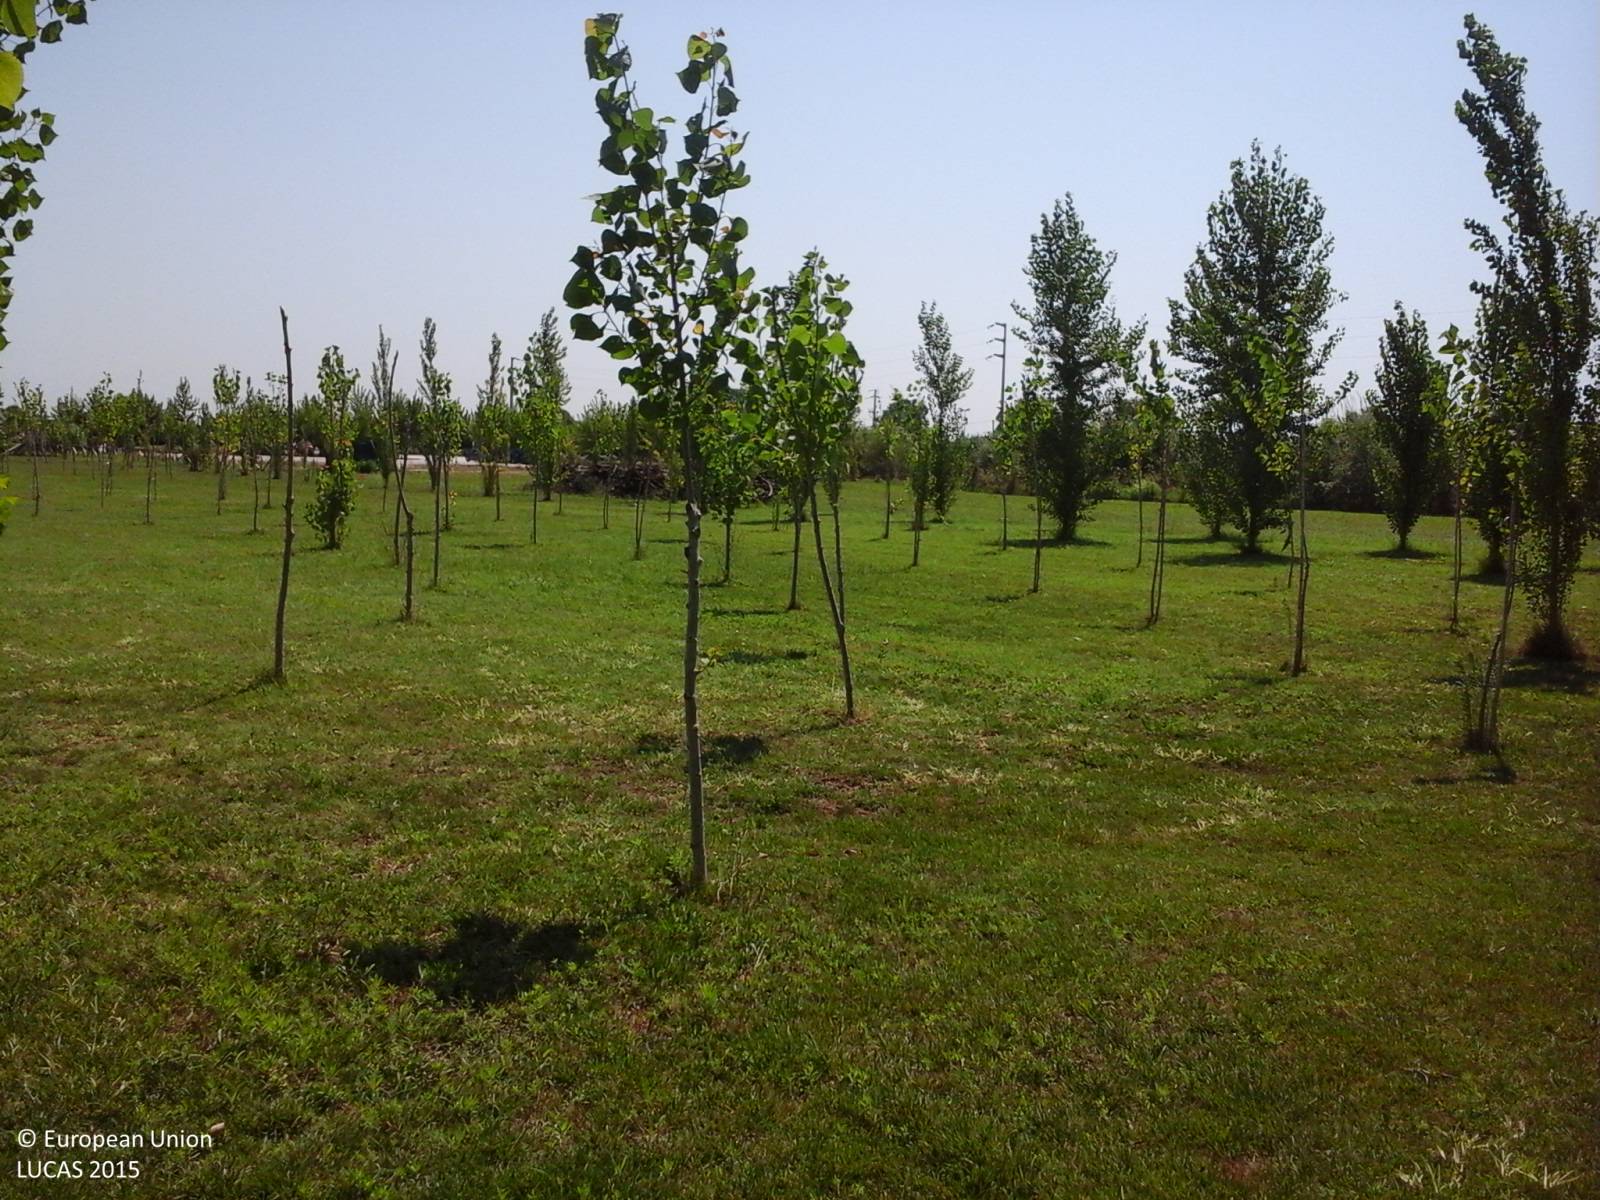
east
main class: Woodland
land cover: Broadleaved woodland
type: non-riverine alder, birch or aspen forest
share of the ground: > 75 %
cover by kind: broadleaved forest trees 70 %, herbaceous plants 30 %
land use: Amenities, museums, leisure
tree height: < 5 m
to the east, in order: Broadleaved woodland; Ditches and canals; Spontaneously vegetated surfaces; Artificial constructions in urban areas; Lines of trees; Ditches and canals; Grass margins; Paved roads, cycling and walking lanes; Grass margins; Ditches and canals; Artificial constructions in urban areas
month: July
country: IT
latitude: 41.0944
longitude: 13.9247
